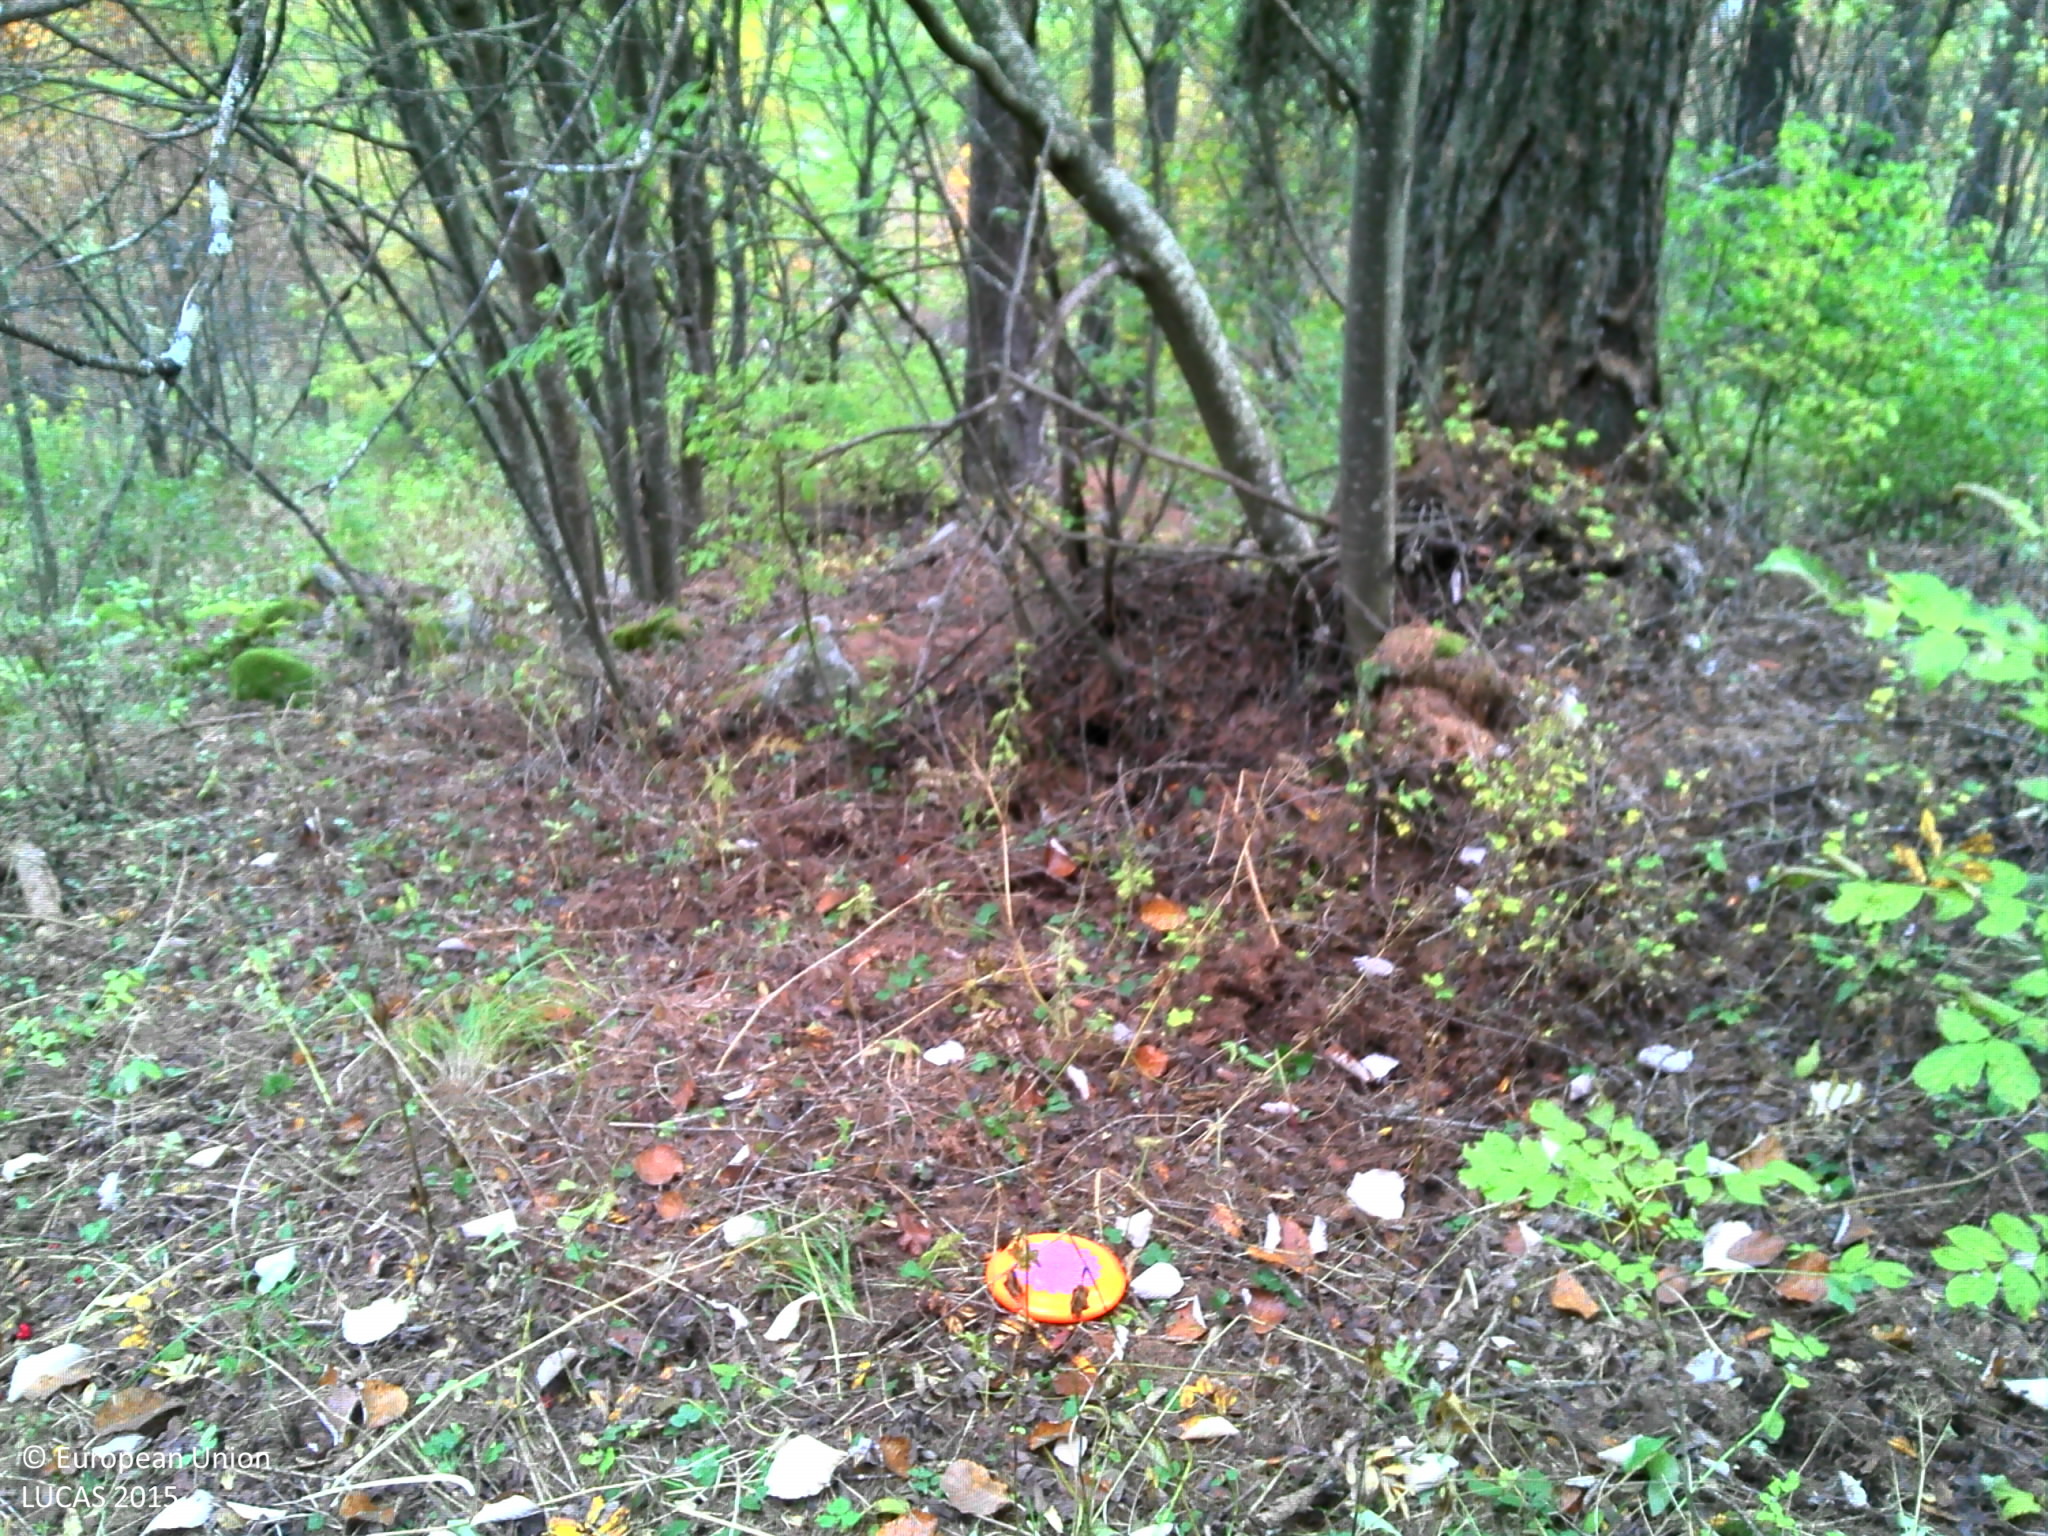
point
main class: Woodland
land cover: Pine dominated mixed woodland
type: hemiboreal forest and nemoral coniferous forest and mixed broadleaved-coniferous forest
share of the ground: > 75 %
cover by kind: coniferous forest trees 35 %, broadleaved forest trees 25 %, shrubs 20 %, herbaceous plants 15 %, consolidated bare surface 5 %
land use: Forestry
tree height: > 5 m
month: October
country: FR
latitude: 44.7799
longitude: 6.5305
